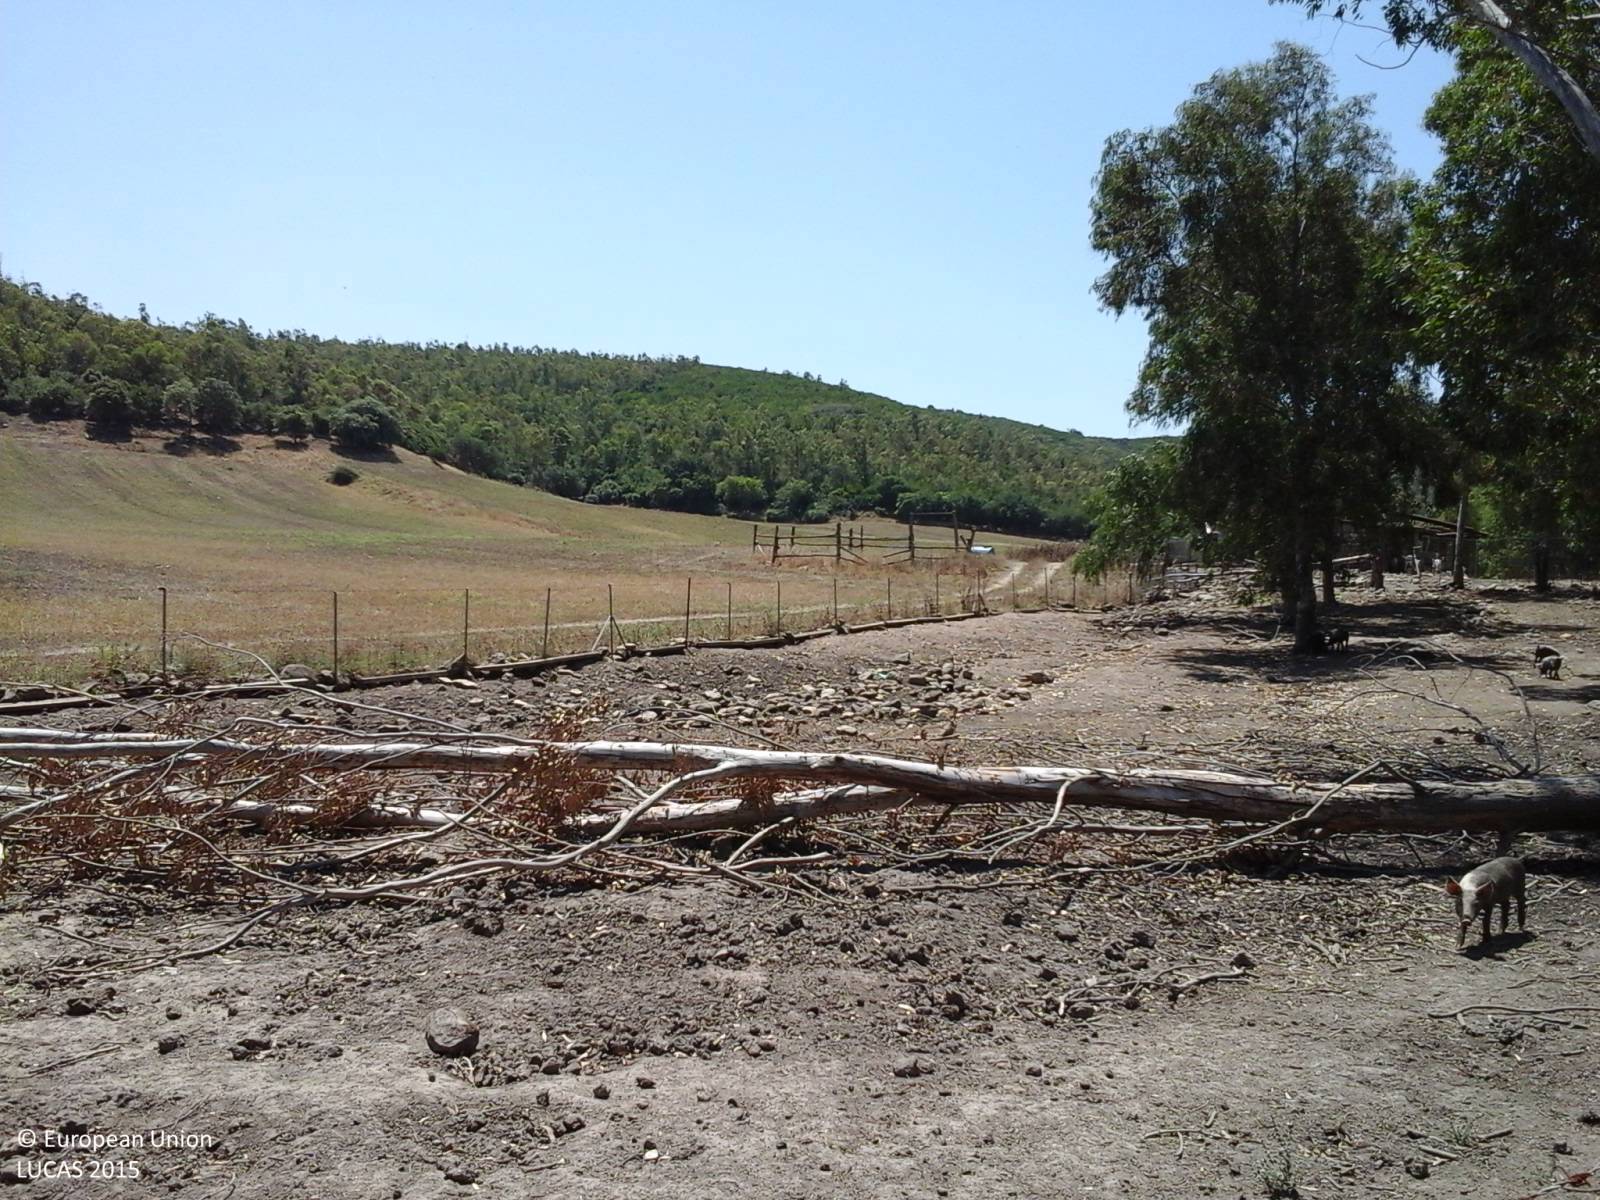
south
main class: Woodland
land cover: Broadleaved woodland
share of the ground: > 75 %
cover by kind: broadleaved forest trees 50 %, unconsolidated bare surface 40 %, herbaceous plants 10 %
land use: Agriculture (excluding fallow land and kitchen gardens)
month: June
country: IT
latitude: 39.8619
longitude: 8.8259
